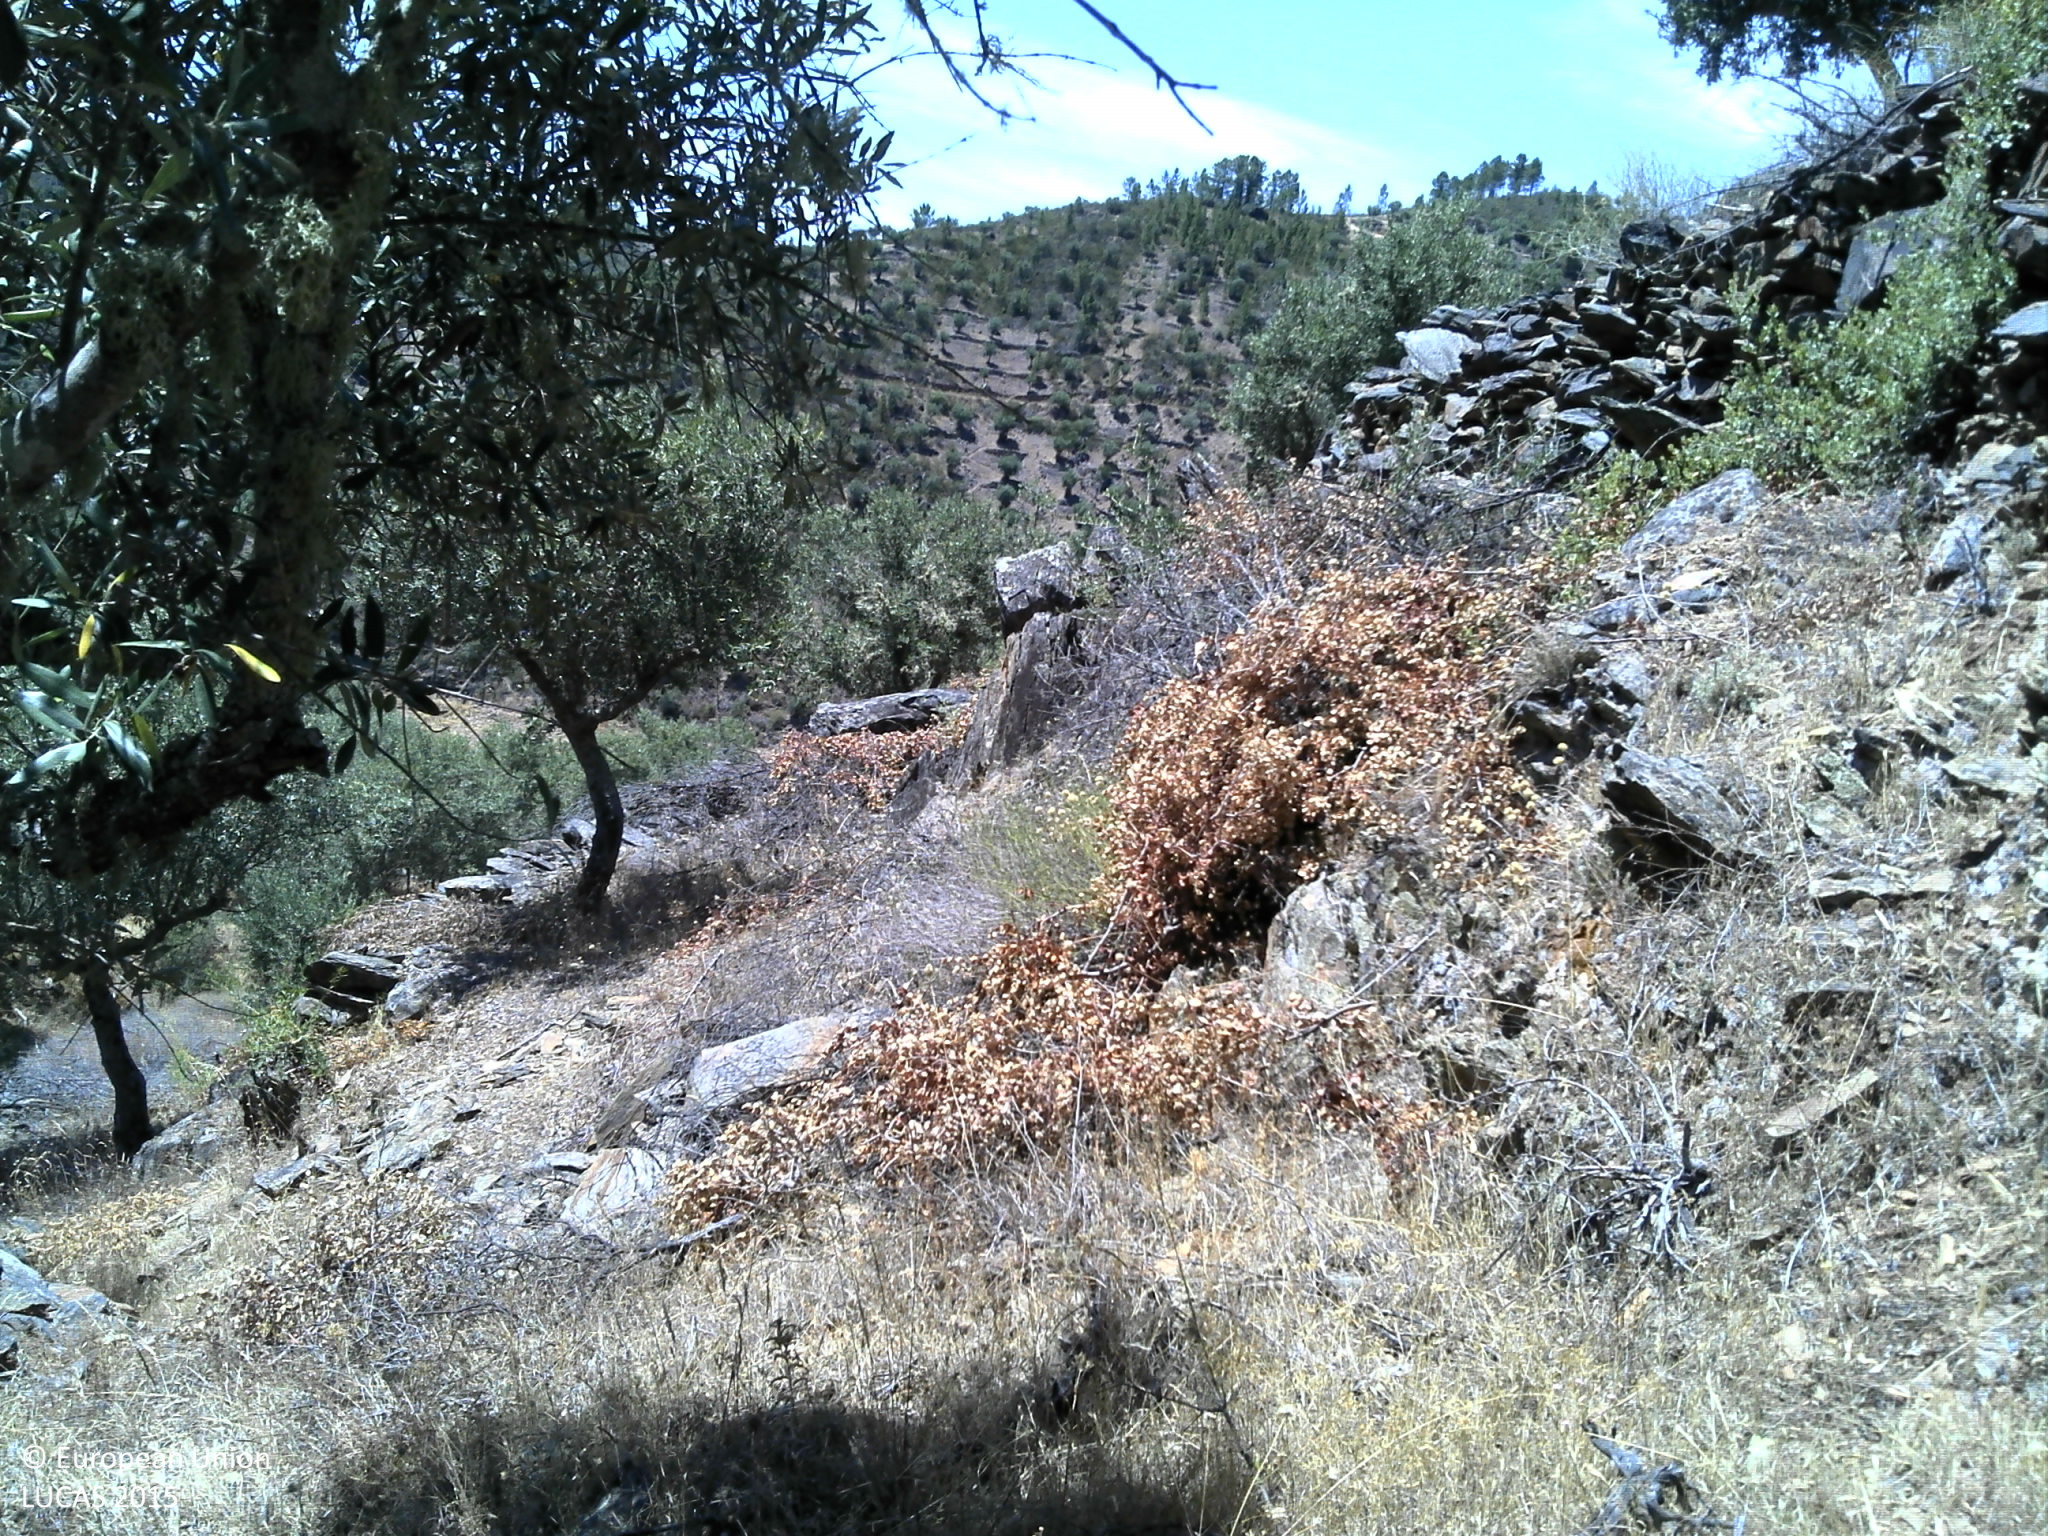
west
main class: Cropland
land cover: Olive groves
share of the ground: 10 - 25 %
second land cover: Grassland without tree/shrub cover
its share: > 75 %
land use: Agriculture (excluding fallow land and kitchen gardens)
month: July
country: PT
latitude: 39.6619
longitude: -7.7855
